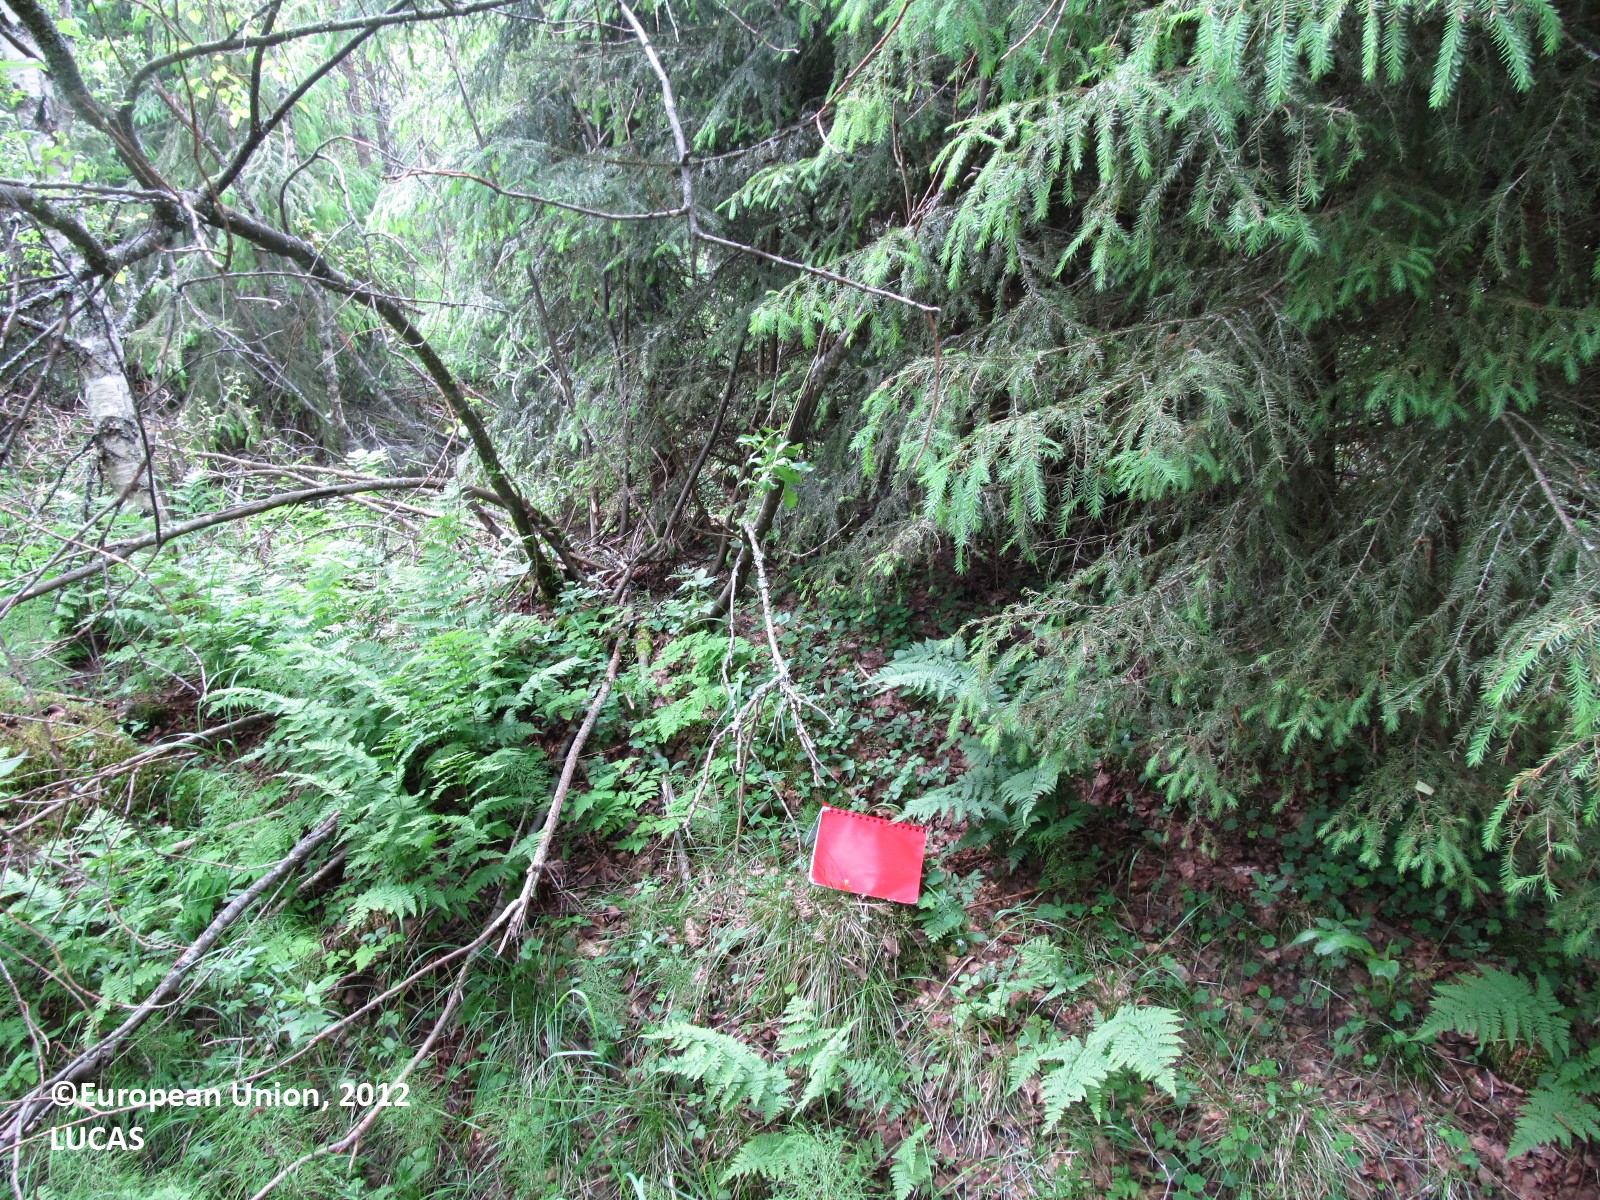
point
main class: Woodland
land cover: Spruce dominated mixed woodland
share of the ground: 50 - 75 %
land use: Forestry
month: June
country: FI
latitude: 63.2407
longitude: 27.7040
